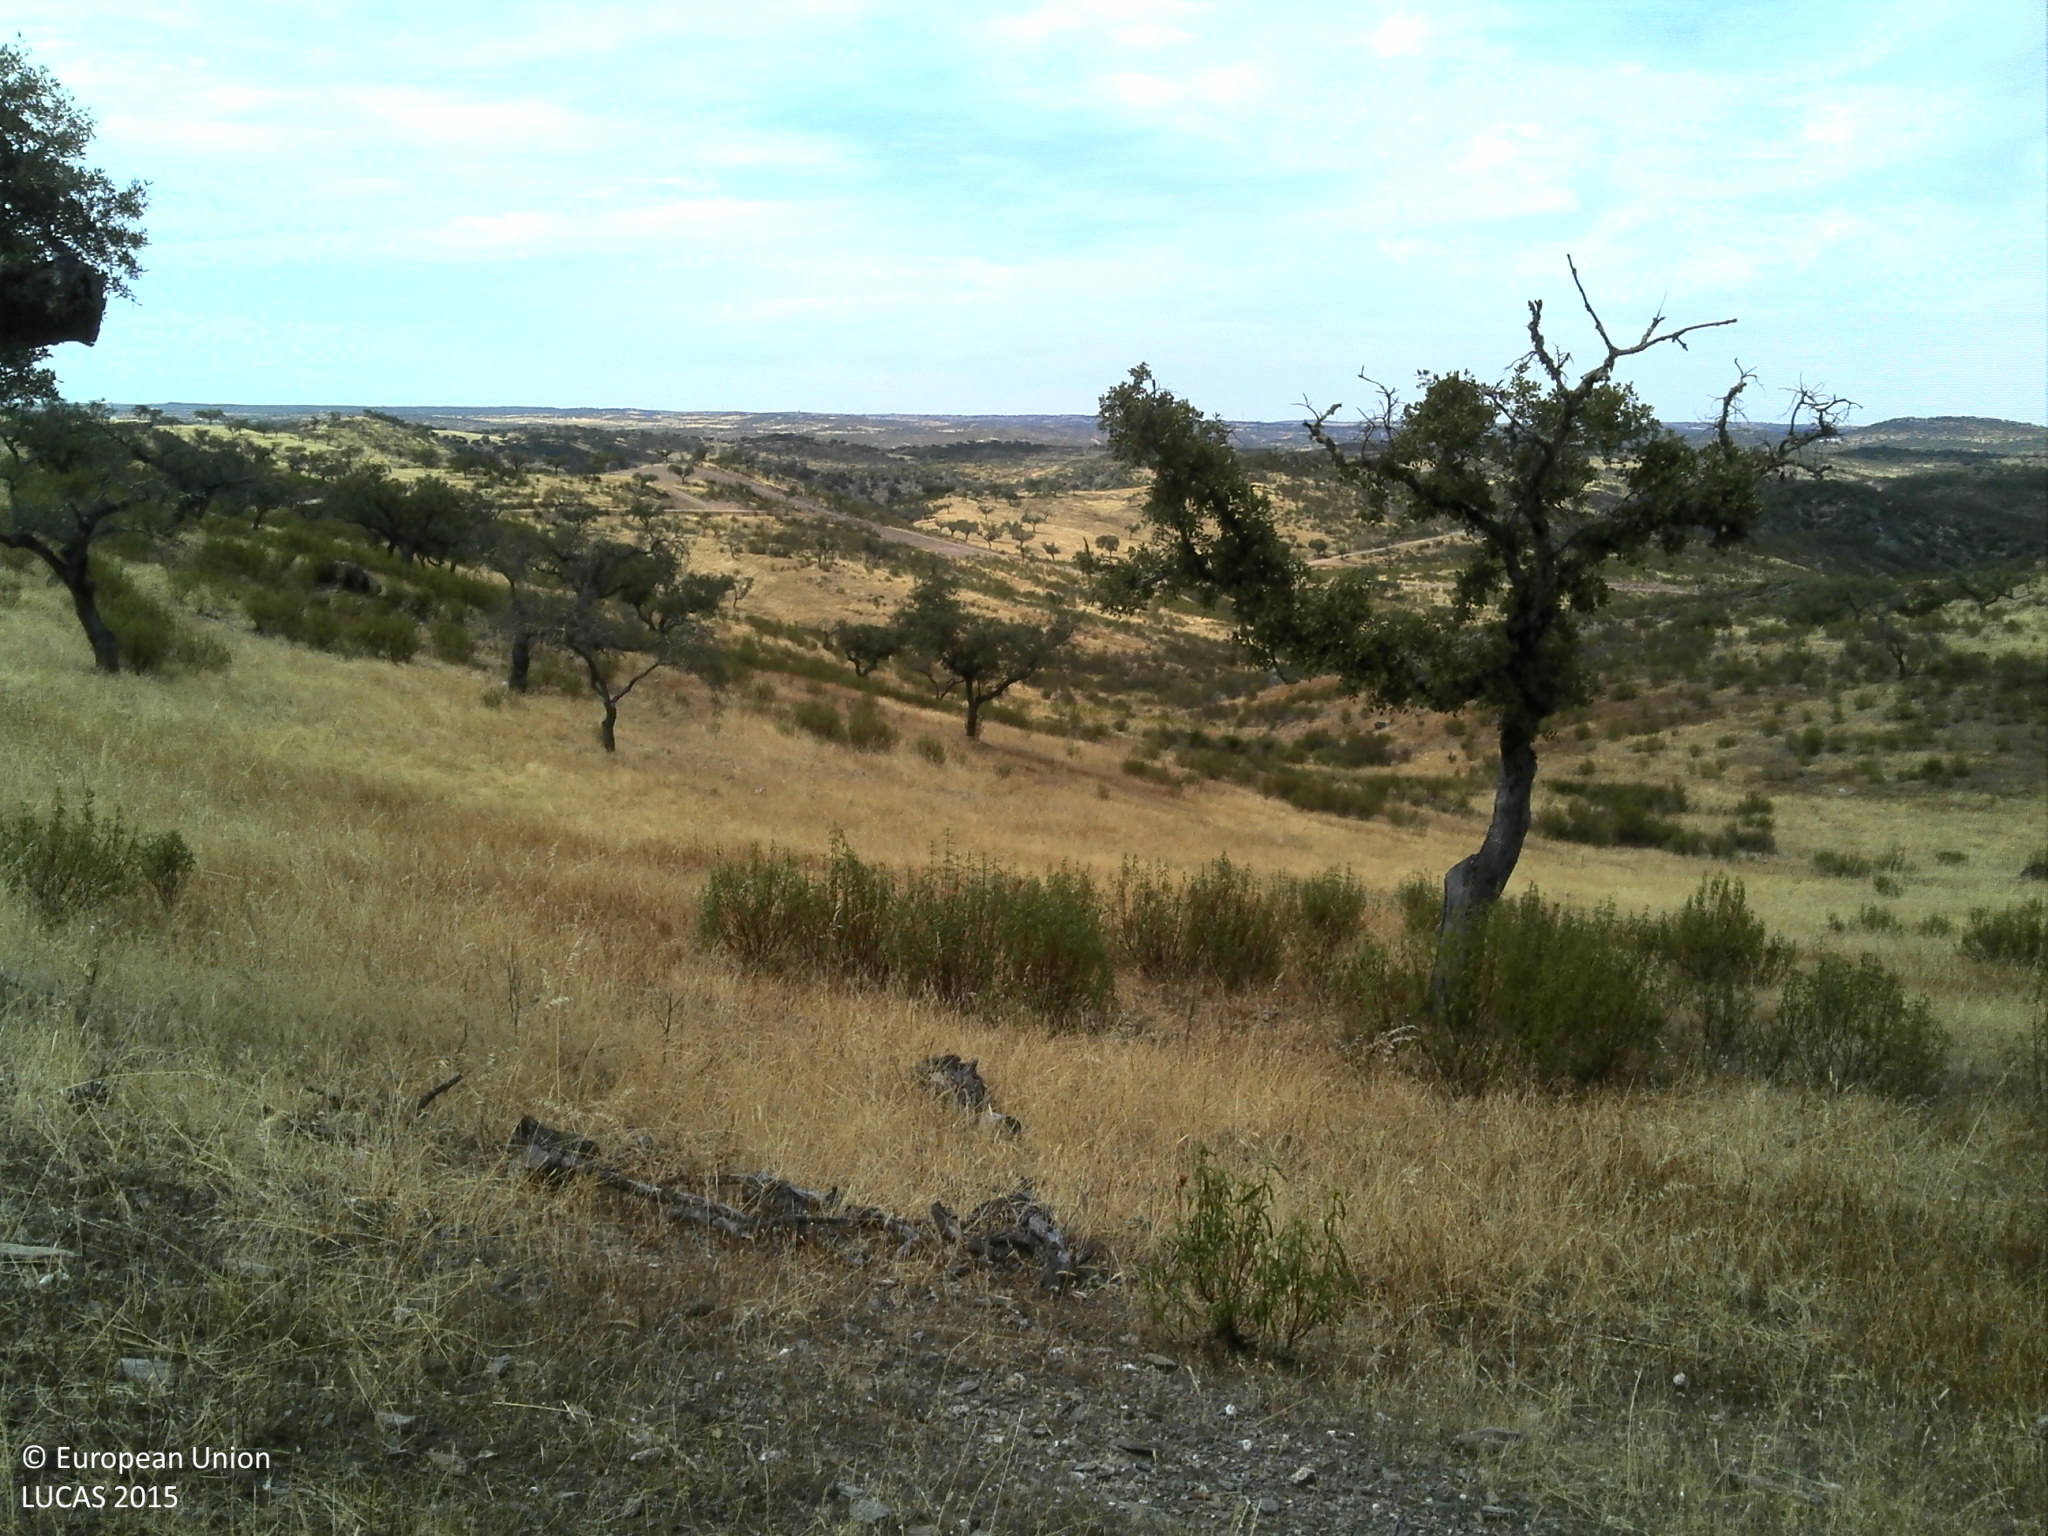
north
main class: Grassland
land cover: Grassland with sparse tree/shrub cover
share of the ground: 50 - 75 %
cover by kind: herbaceous plants 60 %, unconsolidated bare surface 30 %, broadleaved forest trees 5 %, shrubs 5 %
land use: Agriculture (excluding fallow land and kitchen gardens)
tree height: < 5 m
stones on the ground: < 10 %
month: July
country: PT
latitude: 38.1156
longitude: -7.1570
